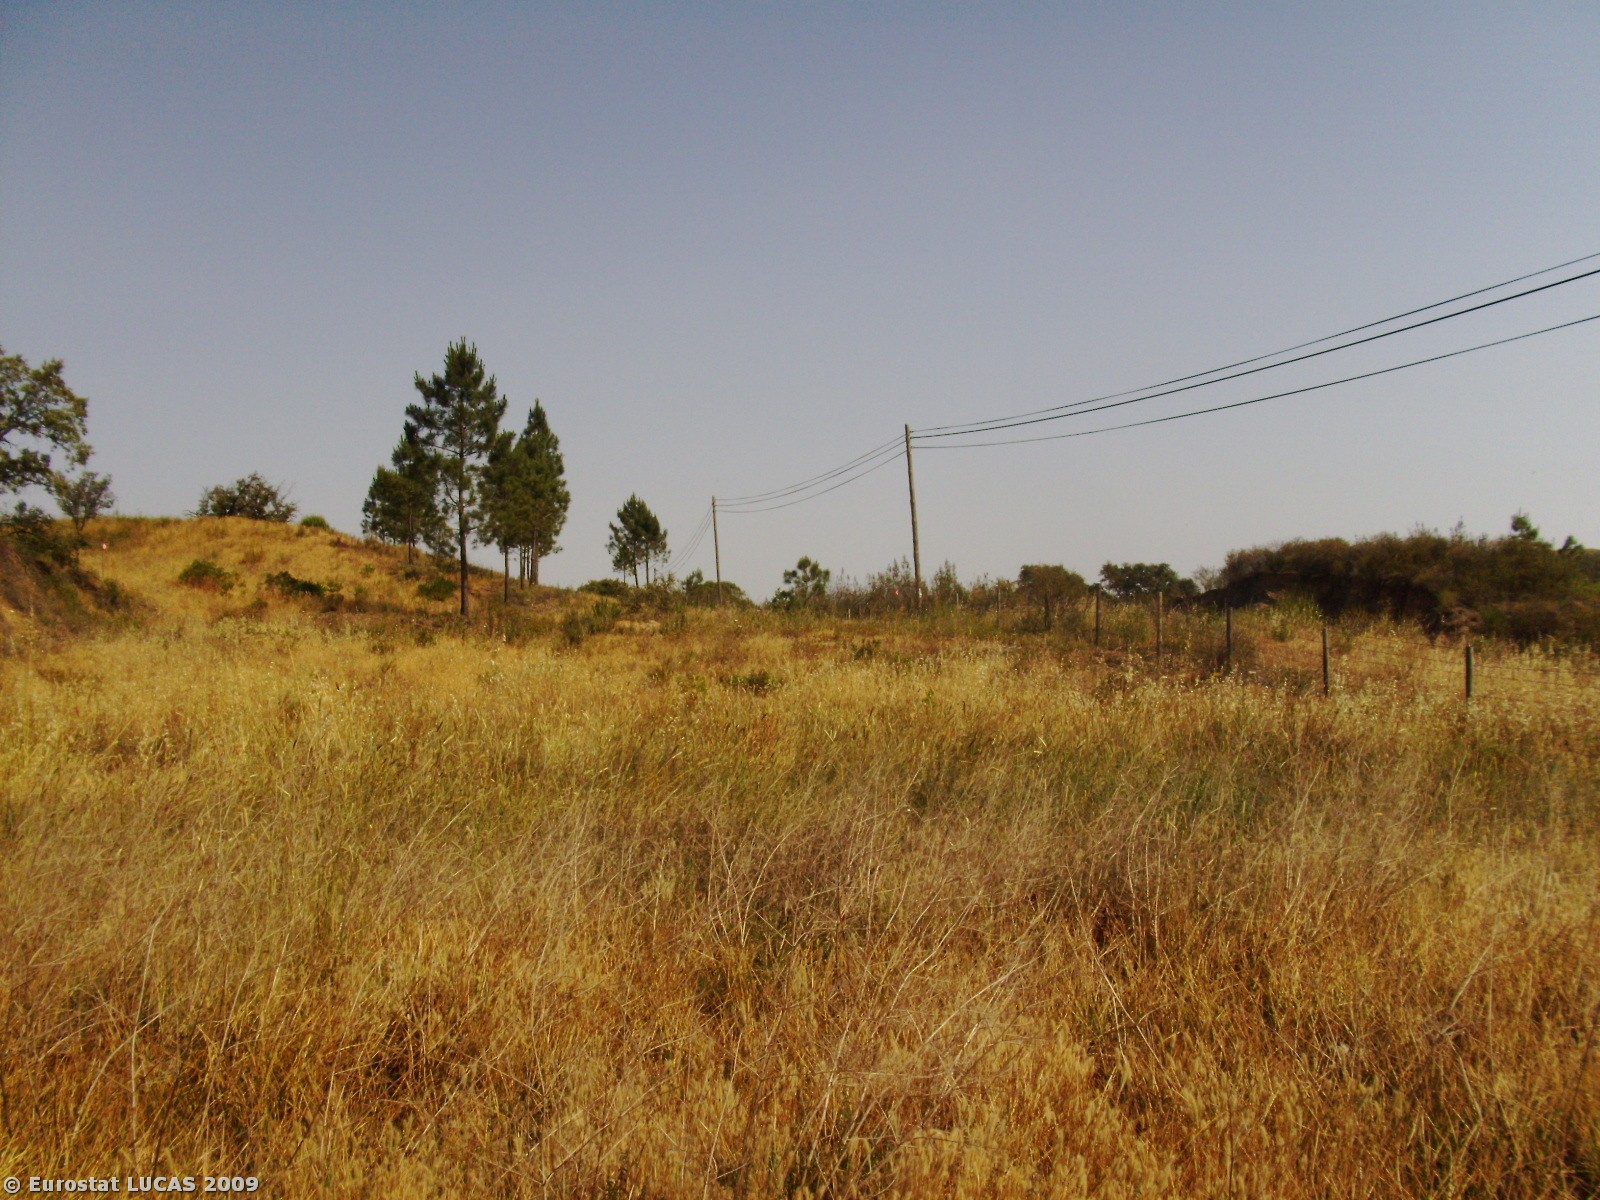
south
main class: Grassland
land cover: Spontaneously vegetated surfaces
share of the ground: > 75 %
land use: Fallow land
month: May
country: PT
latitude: 37.3054
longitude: -8.3123
